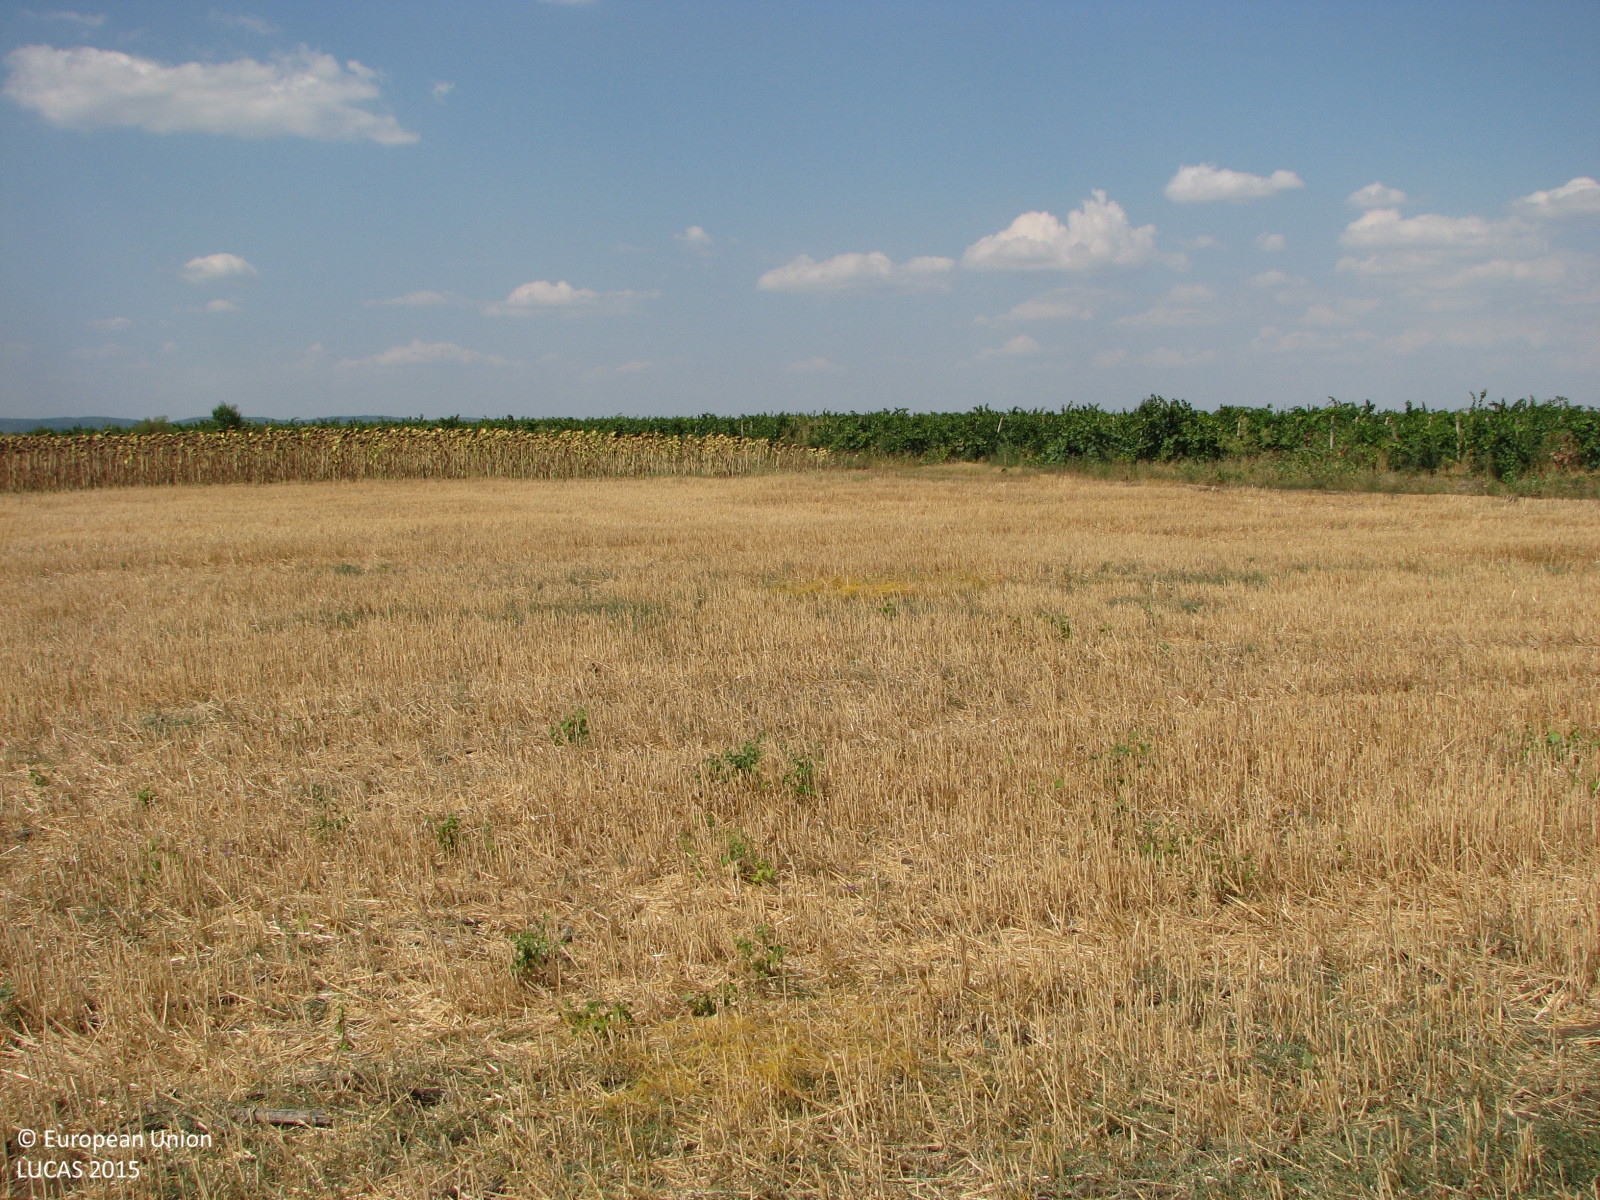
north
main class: Cropland
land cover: Common wheat
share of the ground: 50 - 75 %
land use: Agriculture (excluding fallow land and kitchen gardens)
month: August
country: BG
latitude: 42.5959
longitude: 26.6098
